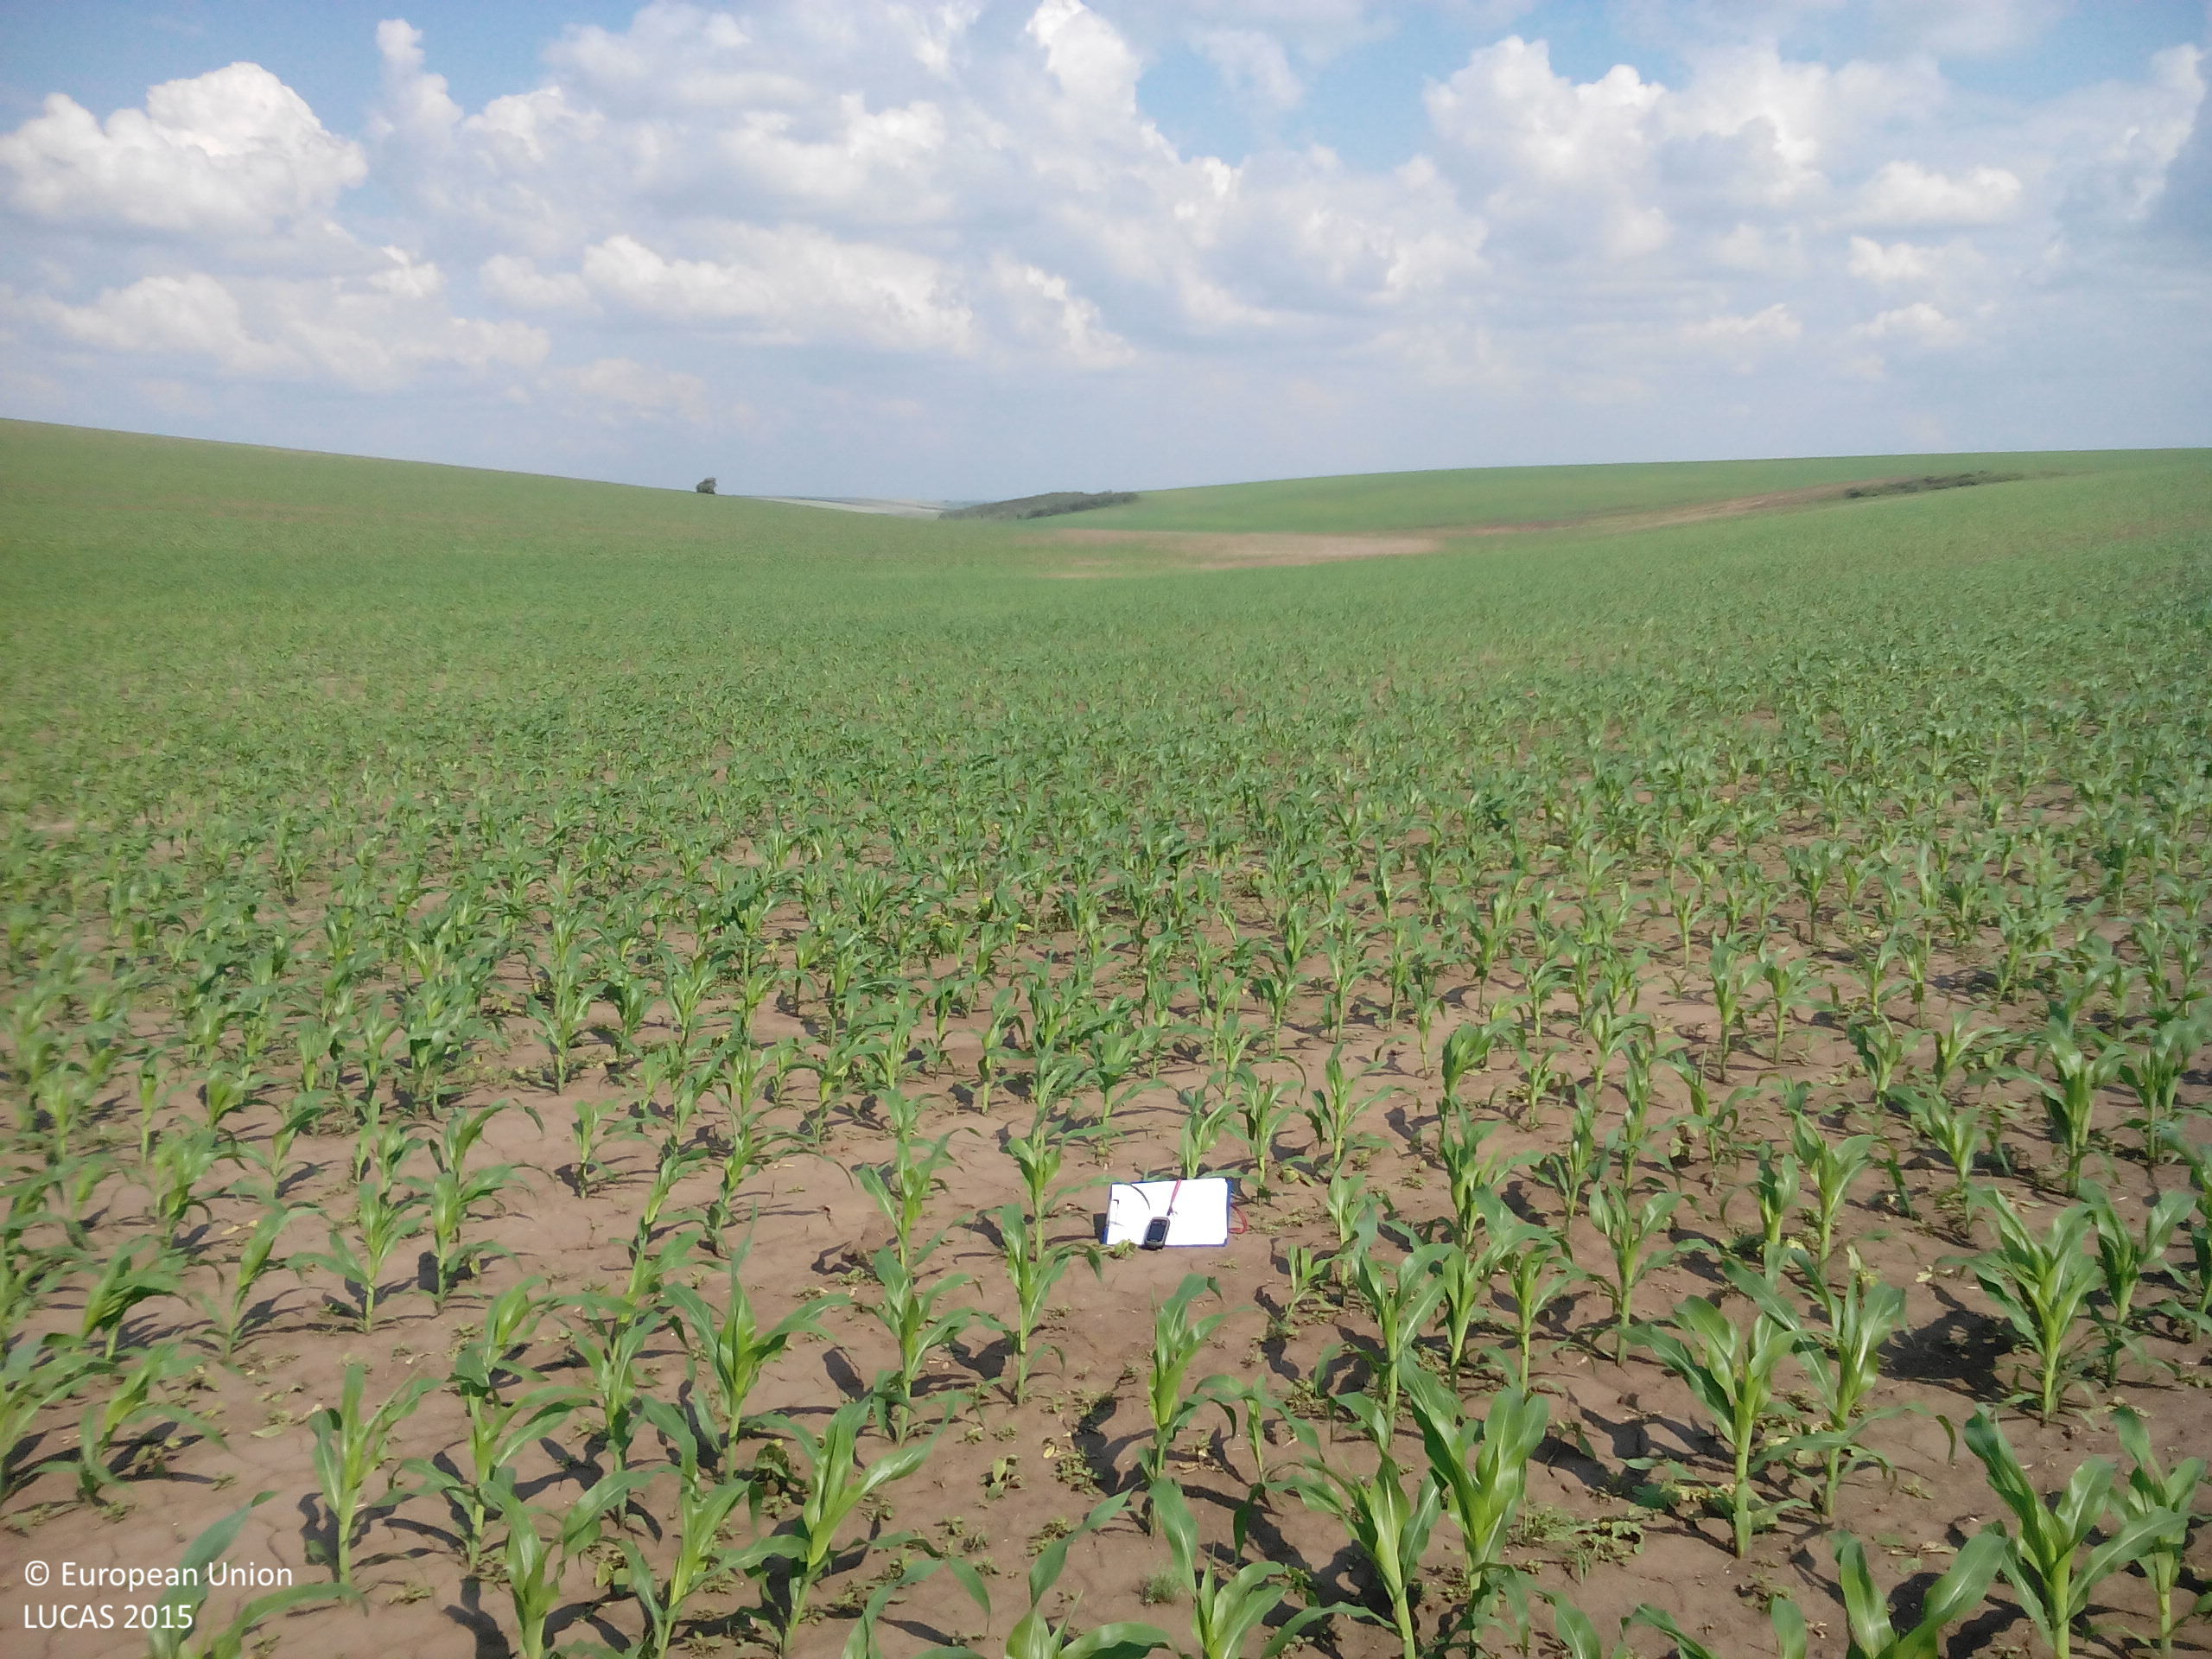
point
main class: Cropland
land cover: Maize
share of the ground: 25 - 50 %
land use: Agriculture (excluding fallow land and kitchen gardens)
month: May
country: BG
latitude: 43.5927
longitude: 24.1647
